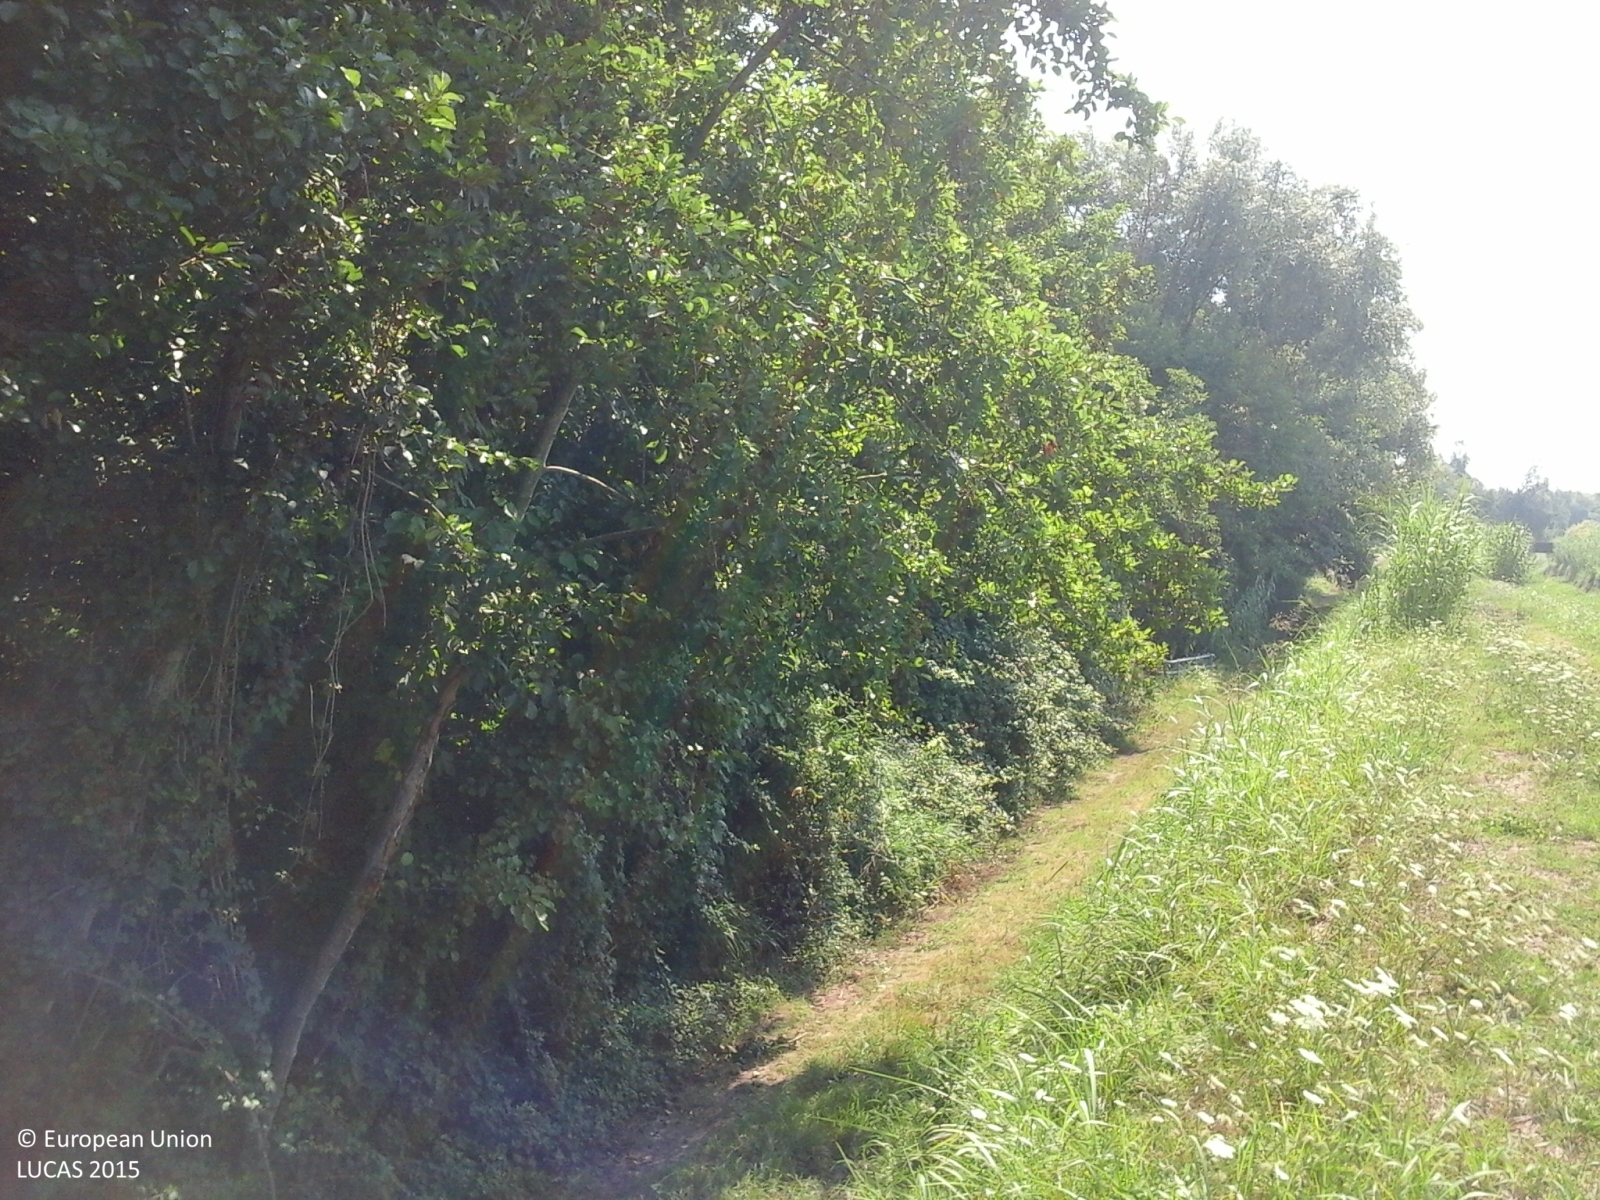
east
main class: Woodland
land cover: Broadleaved woodland
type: thermophilous deciduous forest
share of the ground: > 75 %
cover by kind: broadleaved forest trees 100 %
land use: Semi-natural and natural areas not in use
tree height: > 5 m
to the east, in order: Broadleaved woodland; Inland fresh running water; Broadleaved woodland; Grass margins; Tracks; Grass margins; Abandoned hedges; Inland marshes
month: August
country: IT
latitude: 43.9896
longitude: 10.1617
